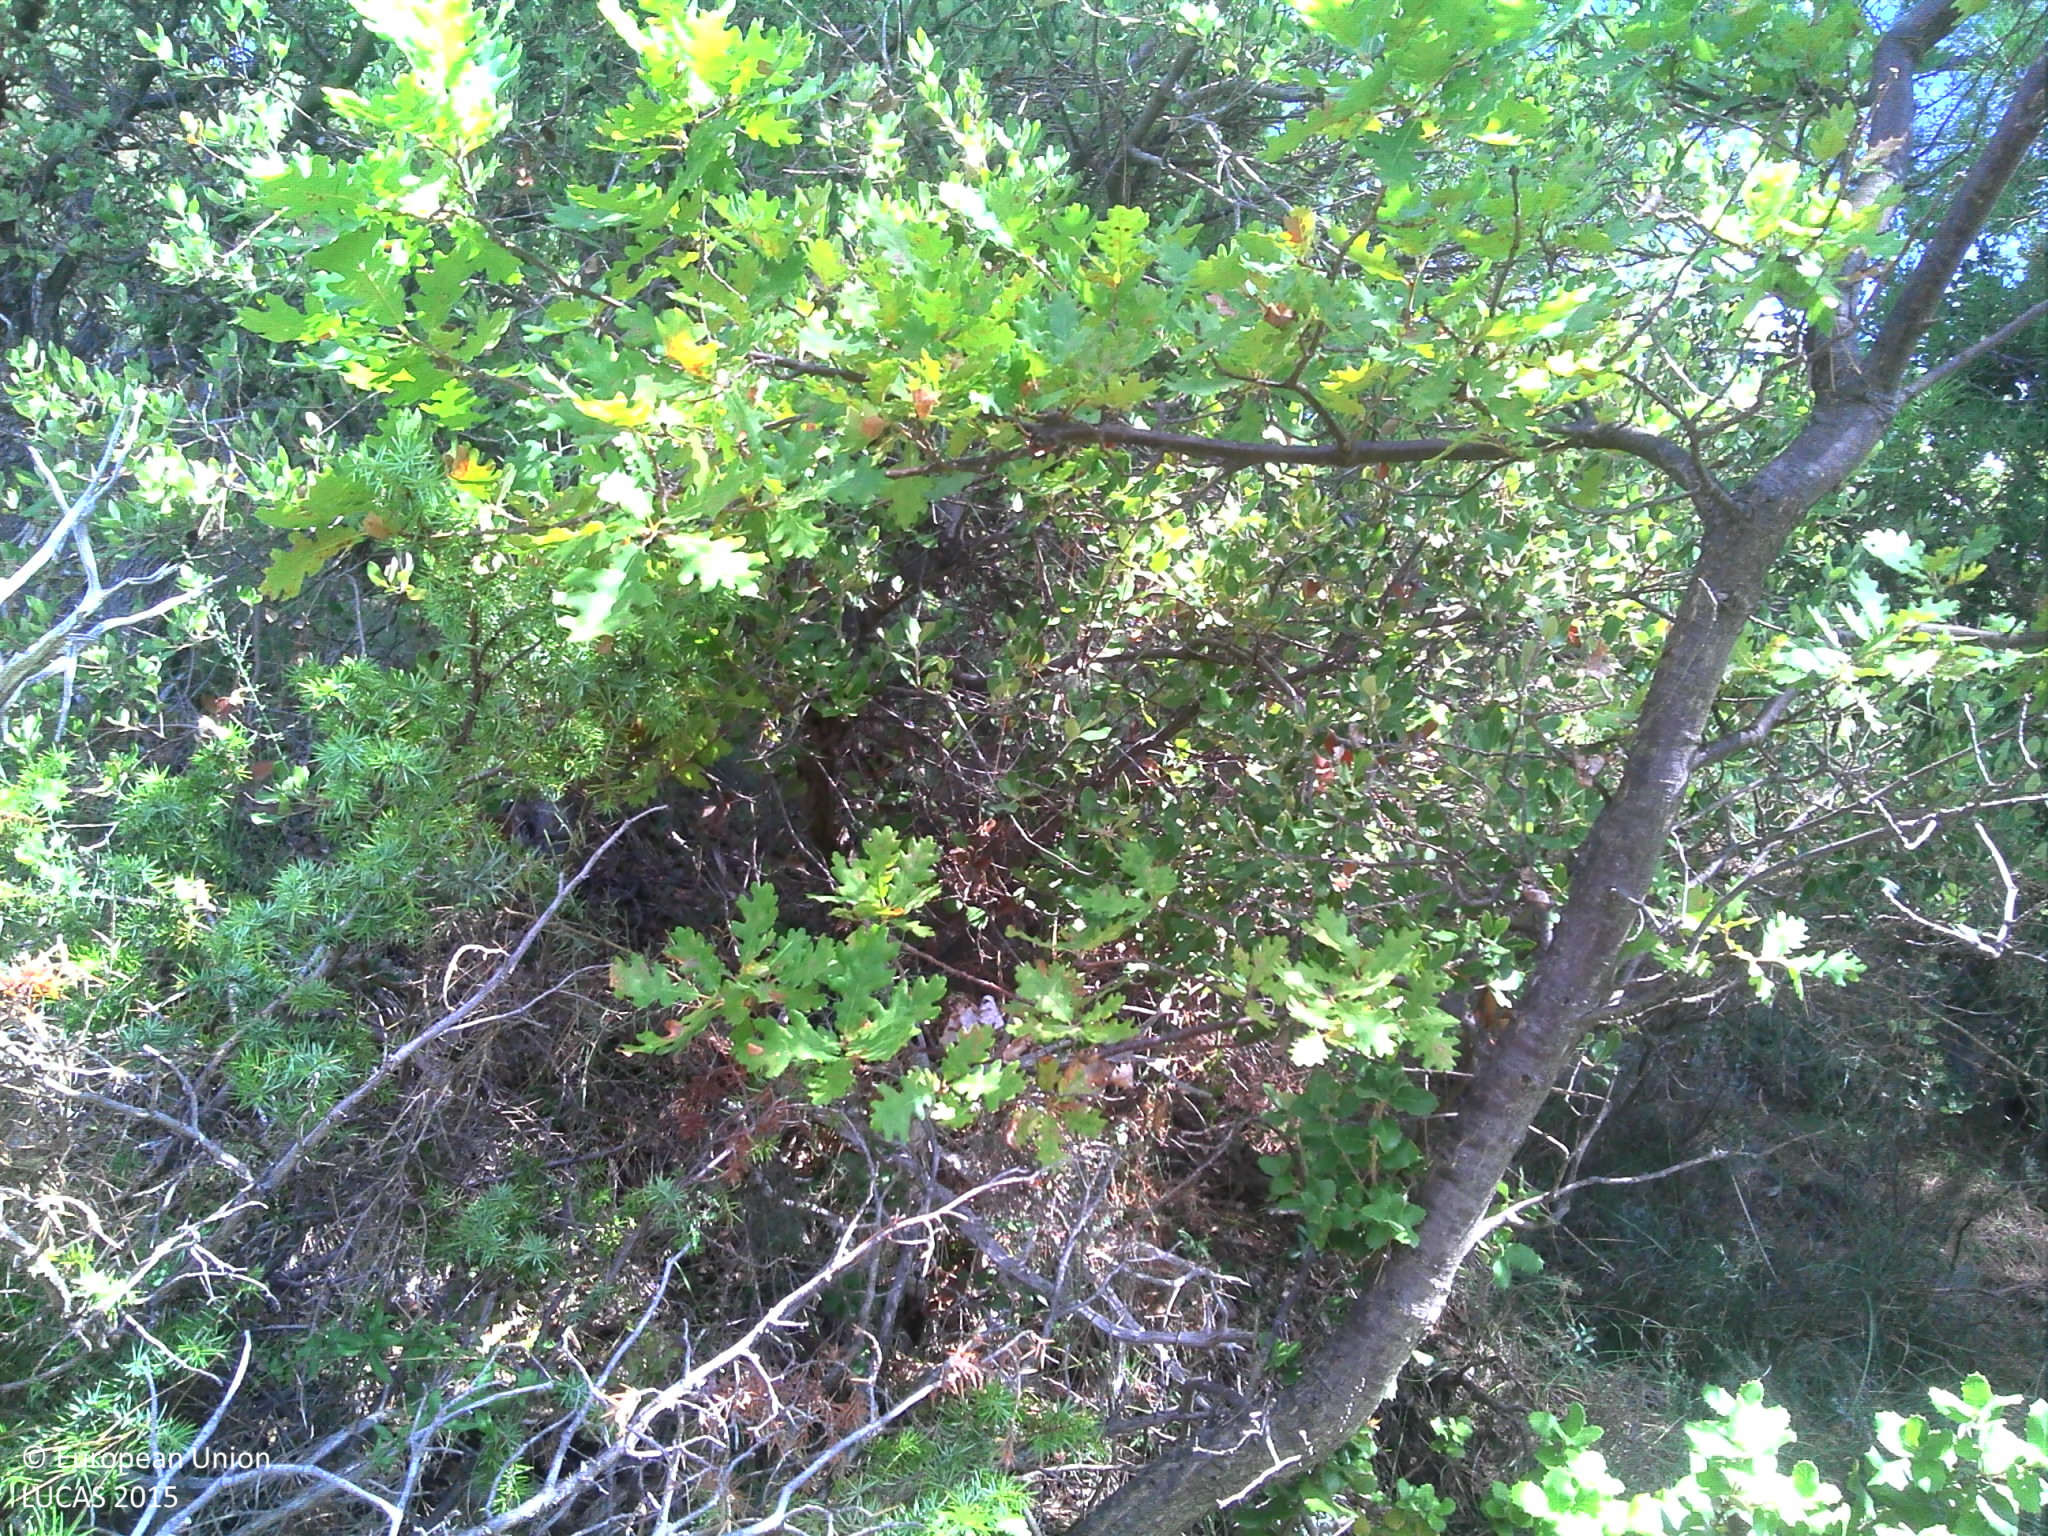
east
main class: Woodland
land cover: Pine dominated mixed woodland
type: coniferous forest of the mediterranean region
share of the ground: 50 - 75 %
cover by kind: shrubs 55 %, broadleaved forest trees 25 %, coniferous forest trees 20 %
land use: Agriculture (excluding fallow land and kitchen gardens)
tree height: < 5 m
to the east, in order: Pine dominated mixed woodland; Shrubland without tree cover; Shrubland with sparse tree cover
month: September
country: FR
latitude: 44.2098
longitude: 5.3397
